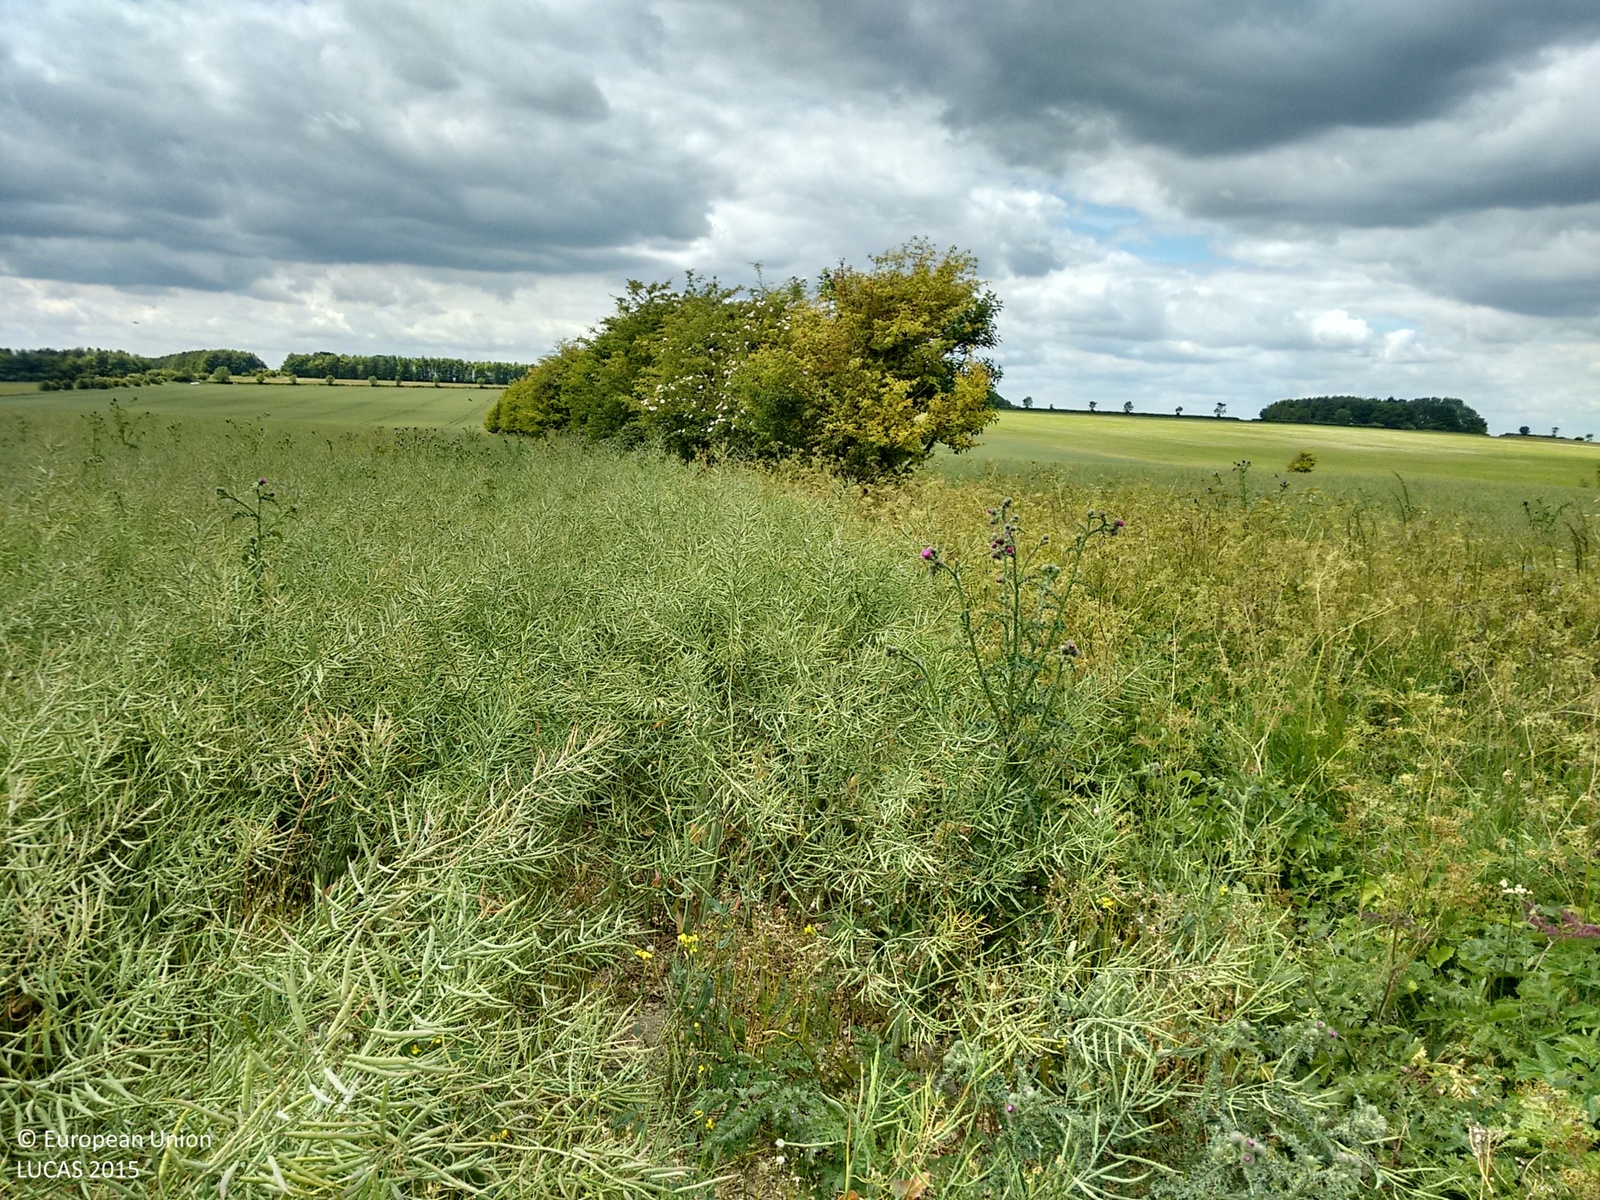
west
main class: Cropland
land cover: Rape and turnip rape
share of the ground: > 75 %
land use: Agriculture (excluding fallow land and kitchen gardens)
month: June
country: GB
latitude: 51.5723
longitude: -1.5806
